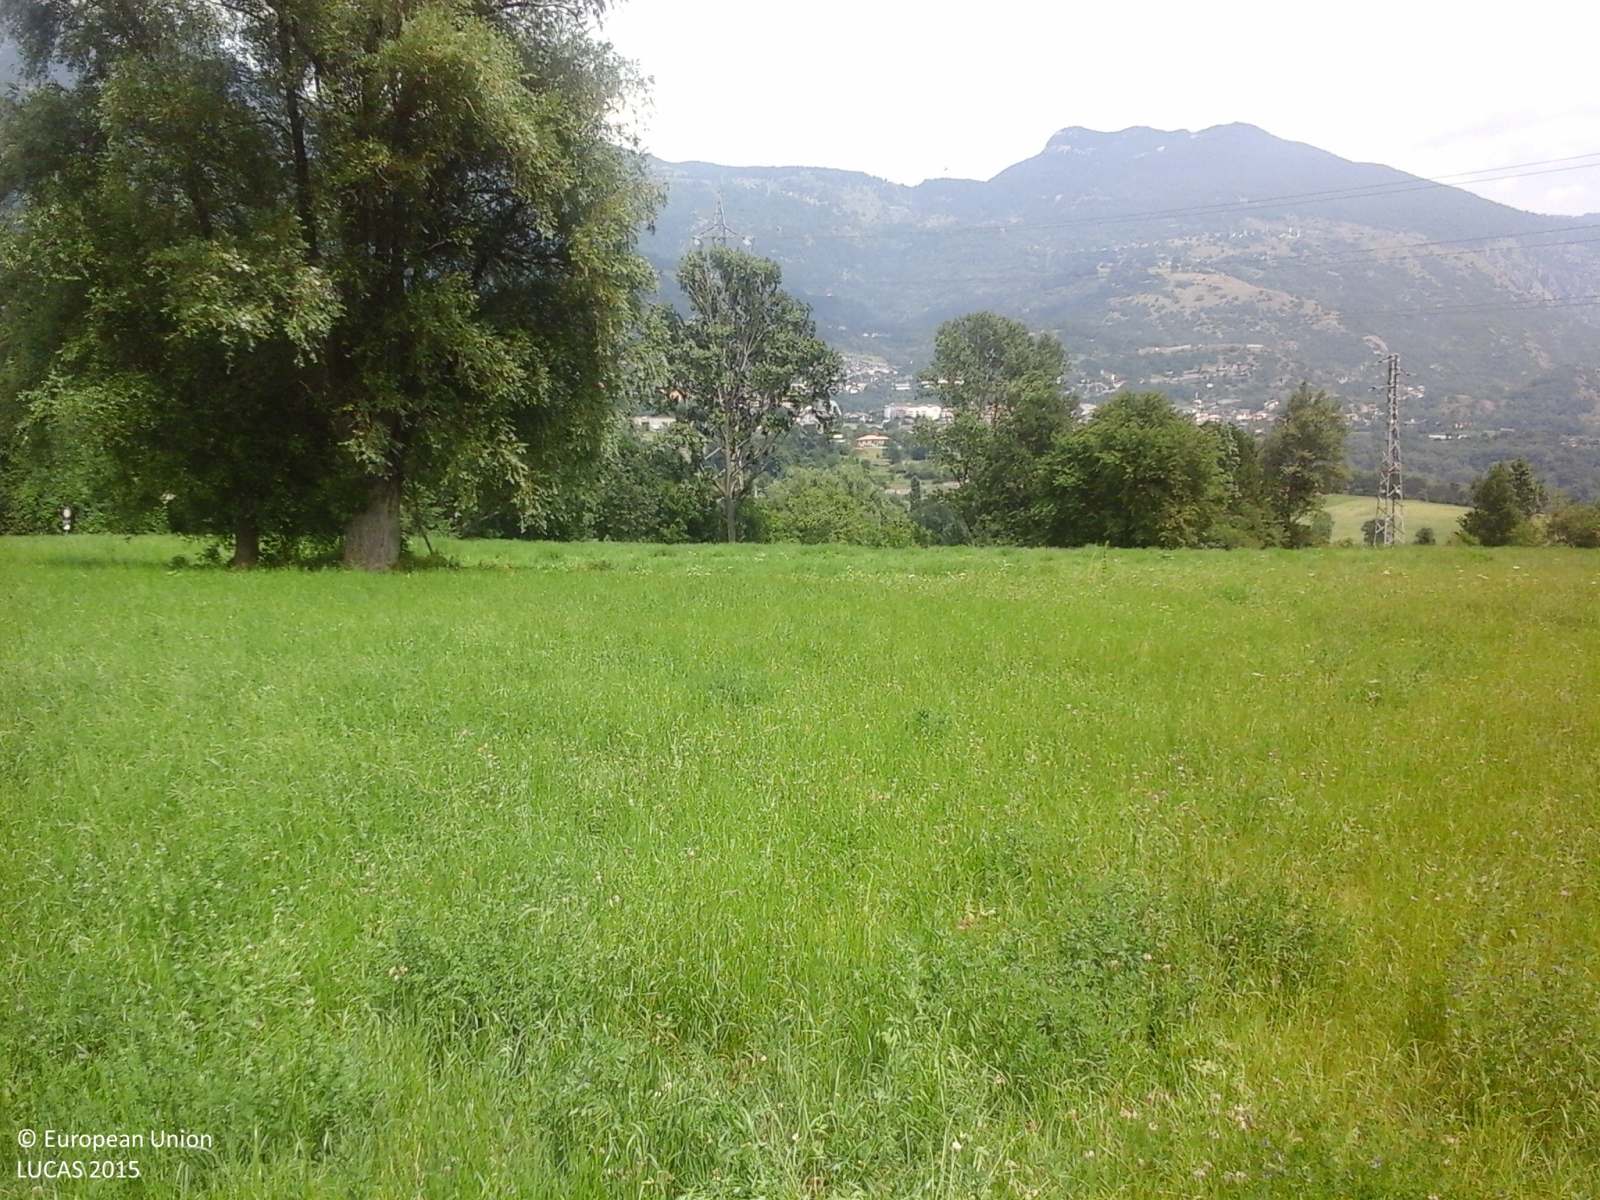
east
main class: Grassland
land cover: Grassland without tree/shrub cover
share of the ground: > 75 %
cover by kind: herbaceous plants 100 %
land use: Agriculture (excluding fallow land and kitchen gardens)
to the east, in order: Grassland without tree/shrub cover; Ditches and canals; Grassland without tree/shrub cover; Tracks; Ditches and canals; Grass margins; Tracks; Broadleaved woodland; Electric lines; Broadleaved woodland; Dry stone walls; Grassland without tree/shrub cover; Ditches and canals; Grassland without tree/shrub cover
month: June
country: IT
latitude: 45.7481
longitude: 7.6253
